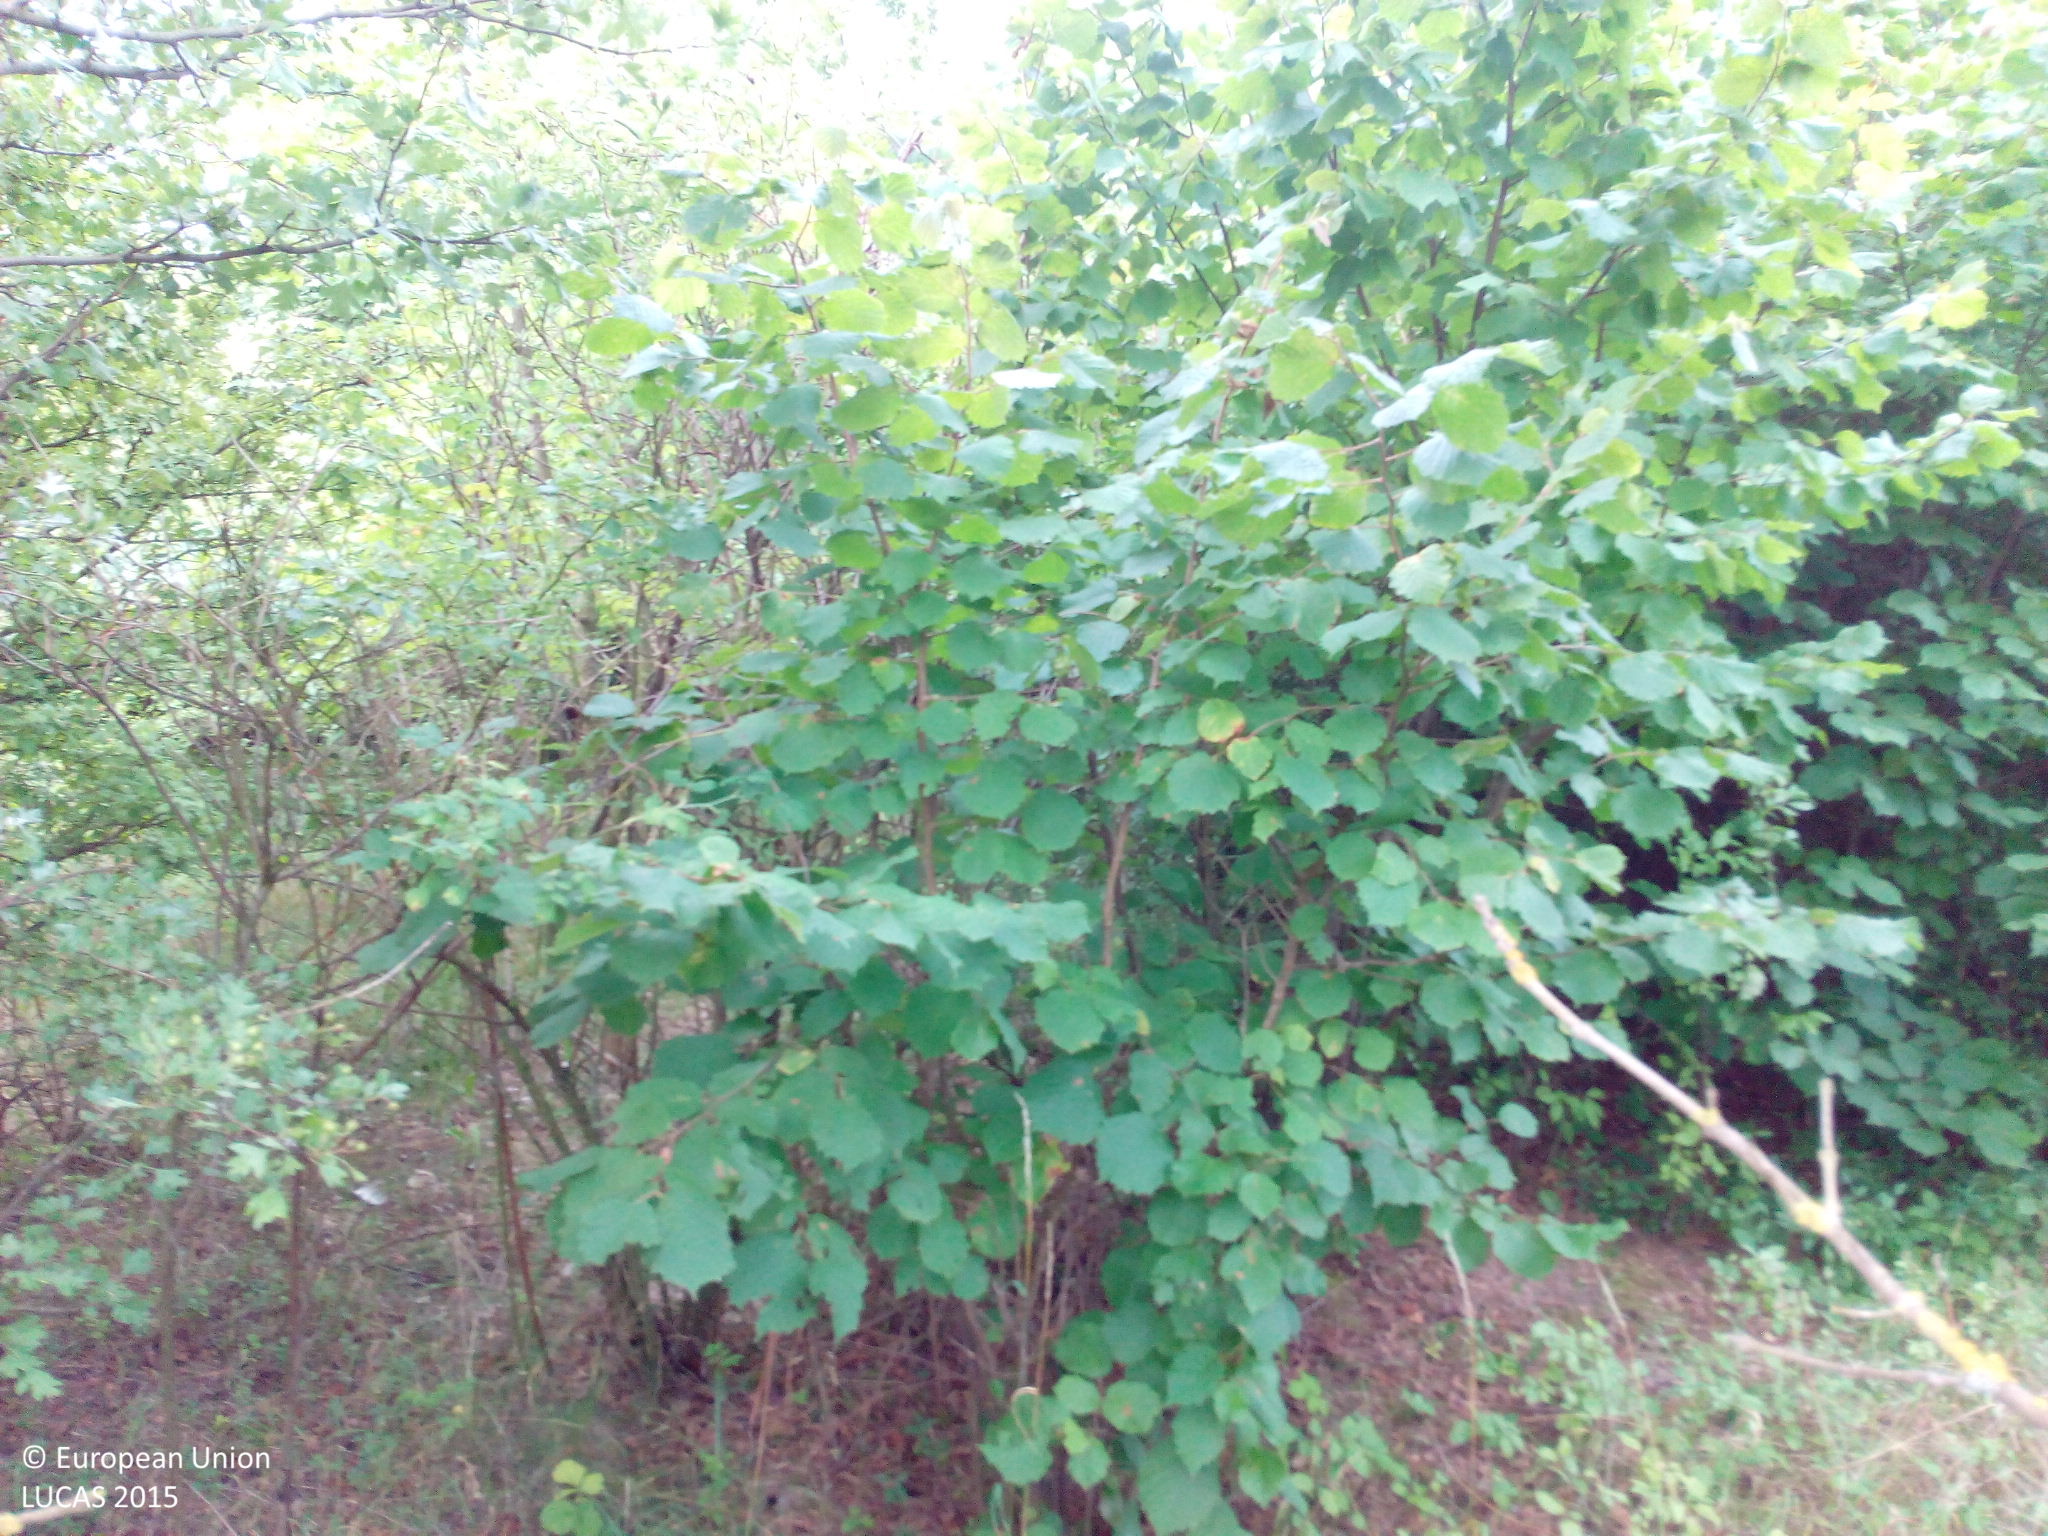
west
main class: Woodland
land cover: Broadleaved woodland
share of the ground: 10 - 25 %
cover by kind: shrubs 70 %, broadleaved forest trees 20 %, herbaceous plants 10 %
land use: Semi-natural and natural areas not in use
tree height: < 5 m
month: July
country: DE
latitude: 52.2213
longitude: 11.7122
